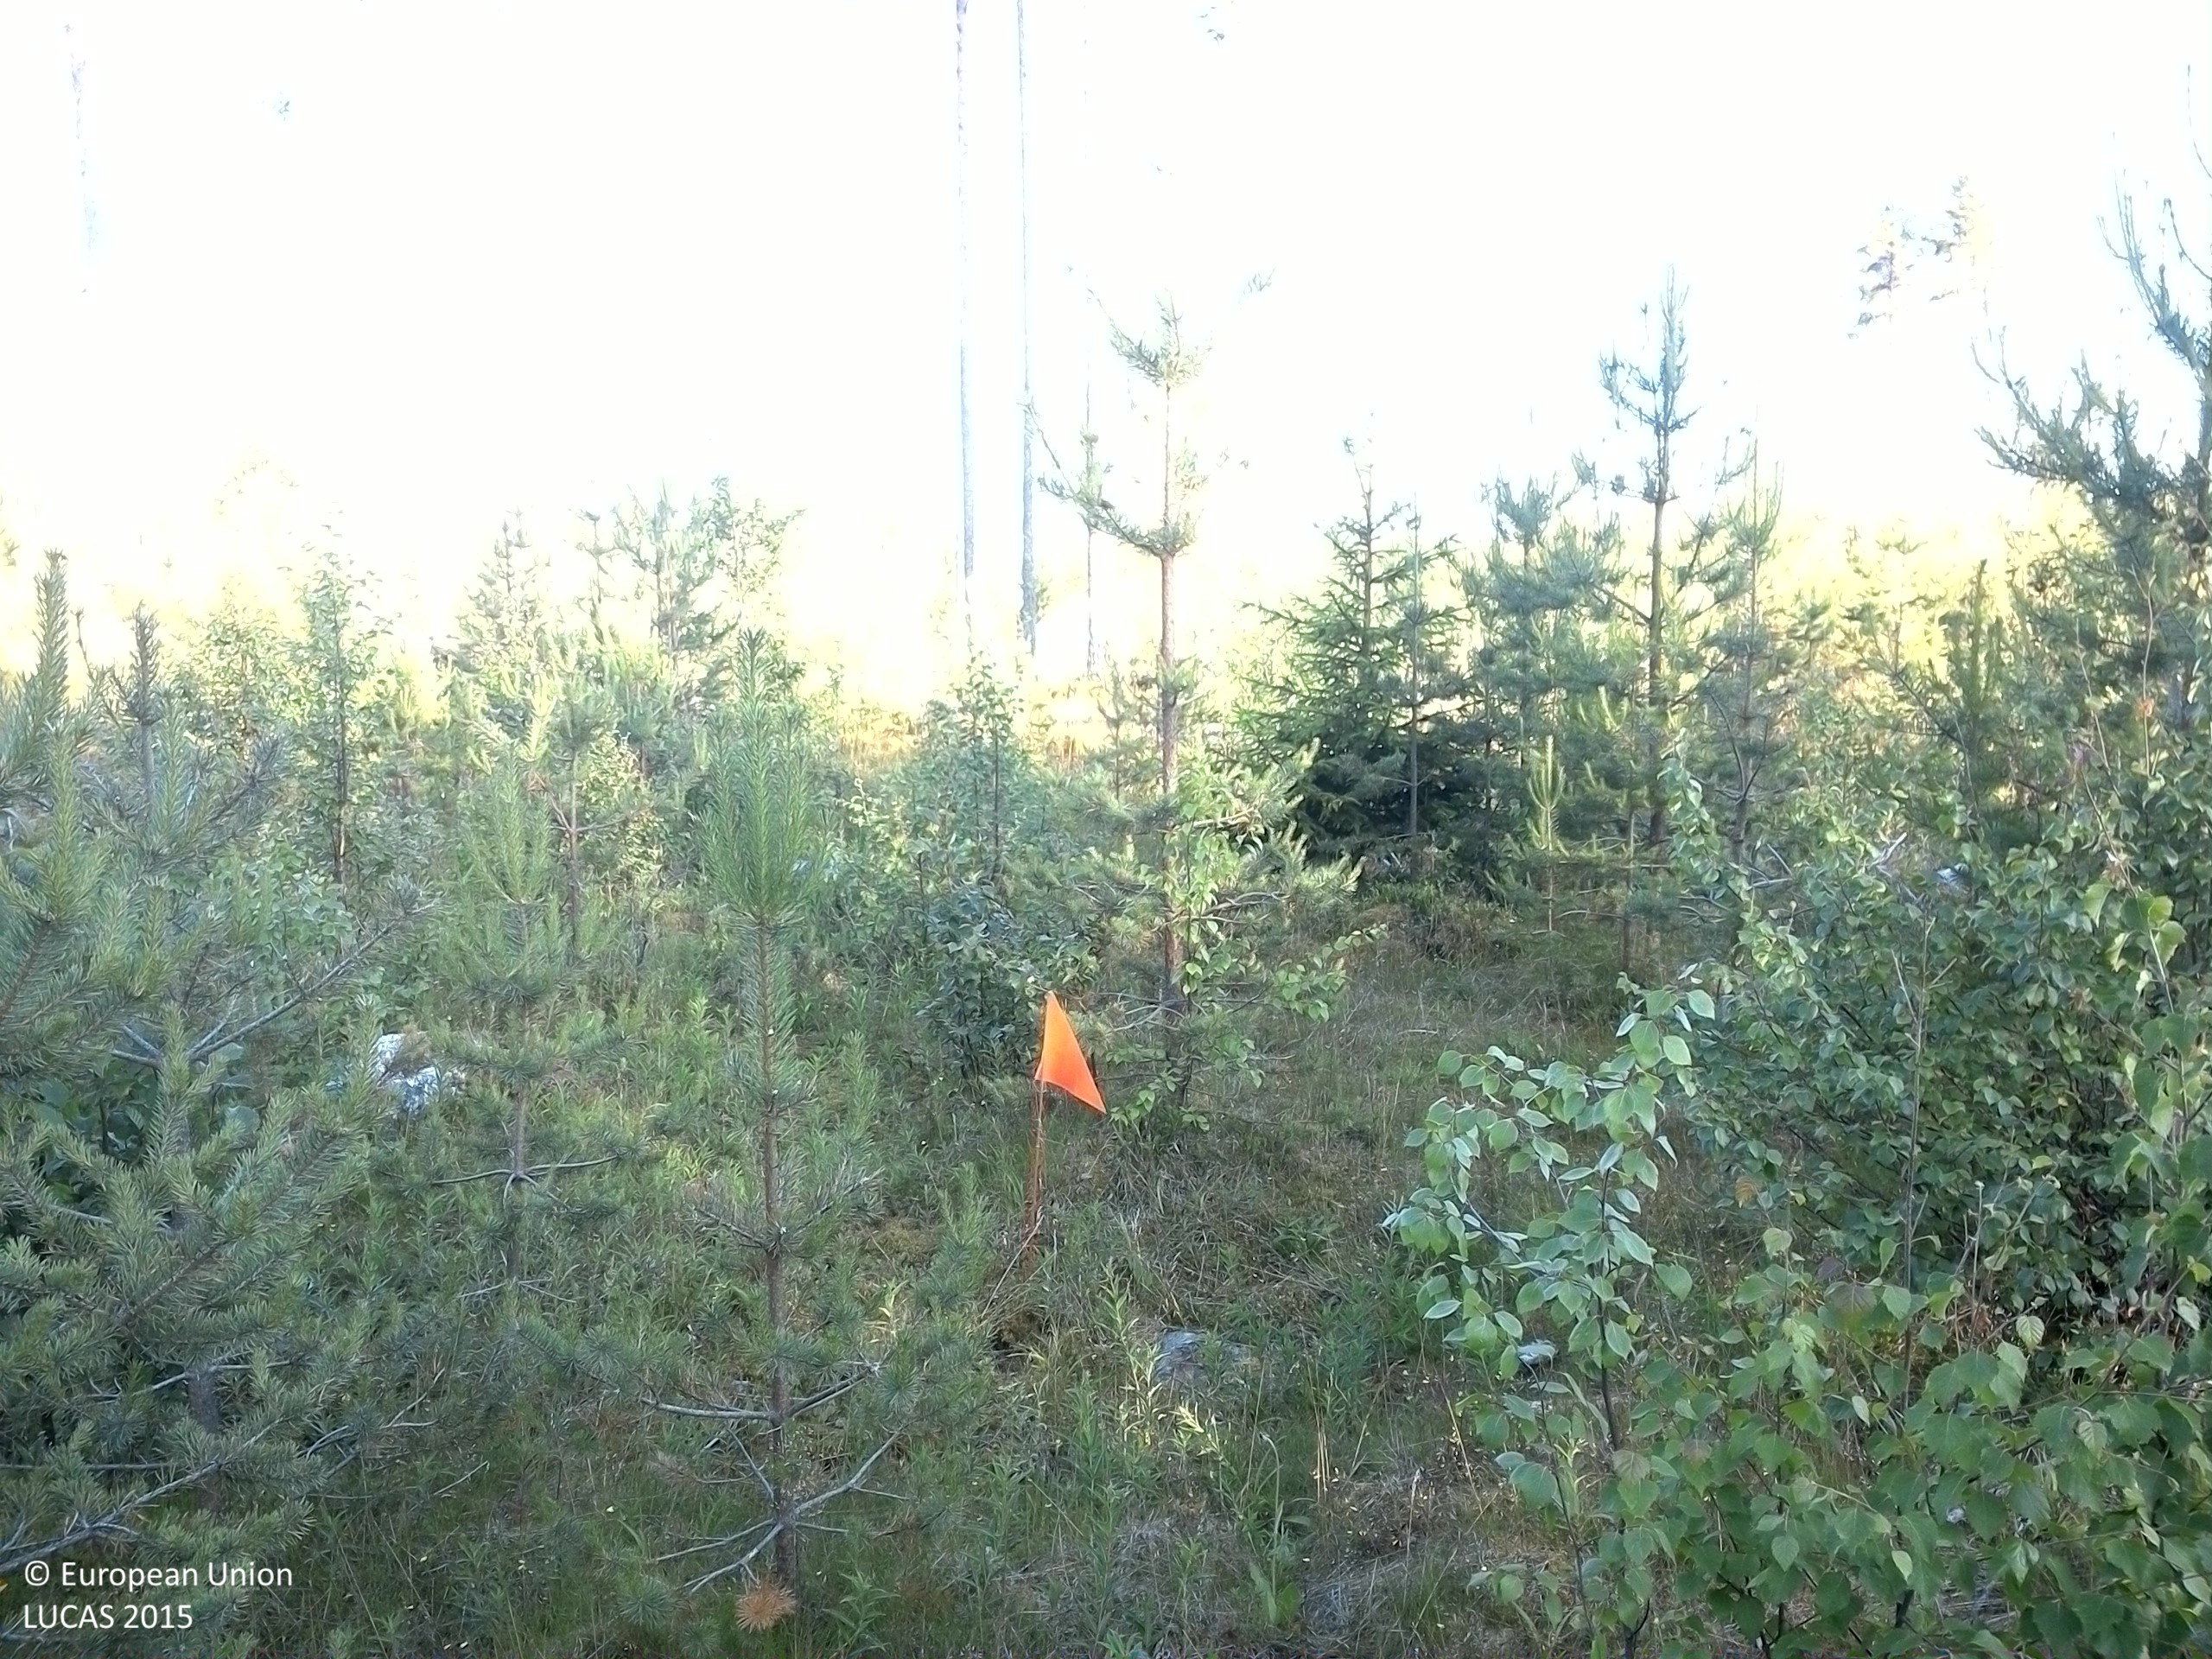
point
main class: Woodland
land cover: Pine dominated mixed woodland
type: boreal forest
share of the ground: 50 - 75 %
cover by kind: coniferous forest trees 45 %, herbaceous plants 20 %, broadleaved forest trees 15 %, shrubs 10 %, lichens and mosses 10 %
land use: Forestry
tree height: < 5 m
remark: Clear cut
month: July
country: SE
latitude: 63.6560
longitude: 17.5472
